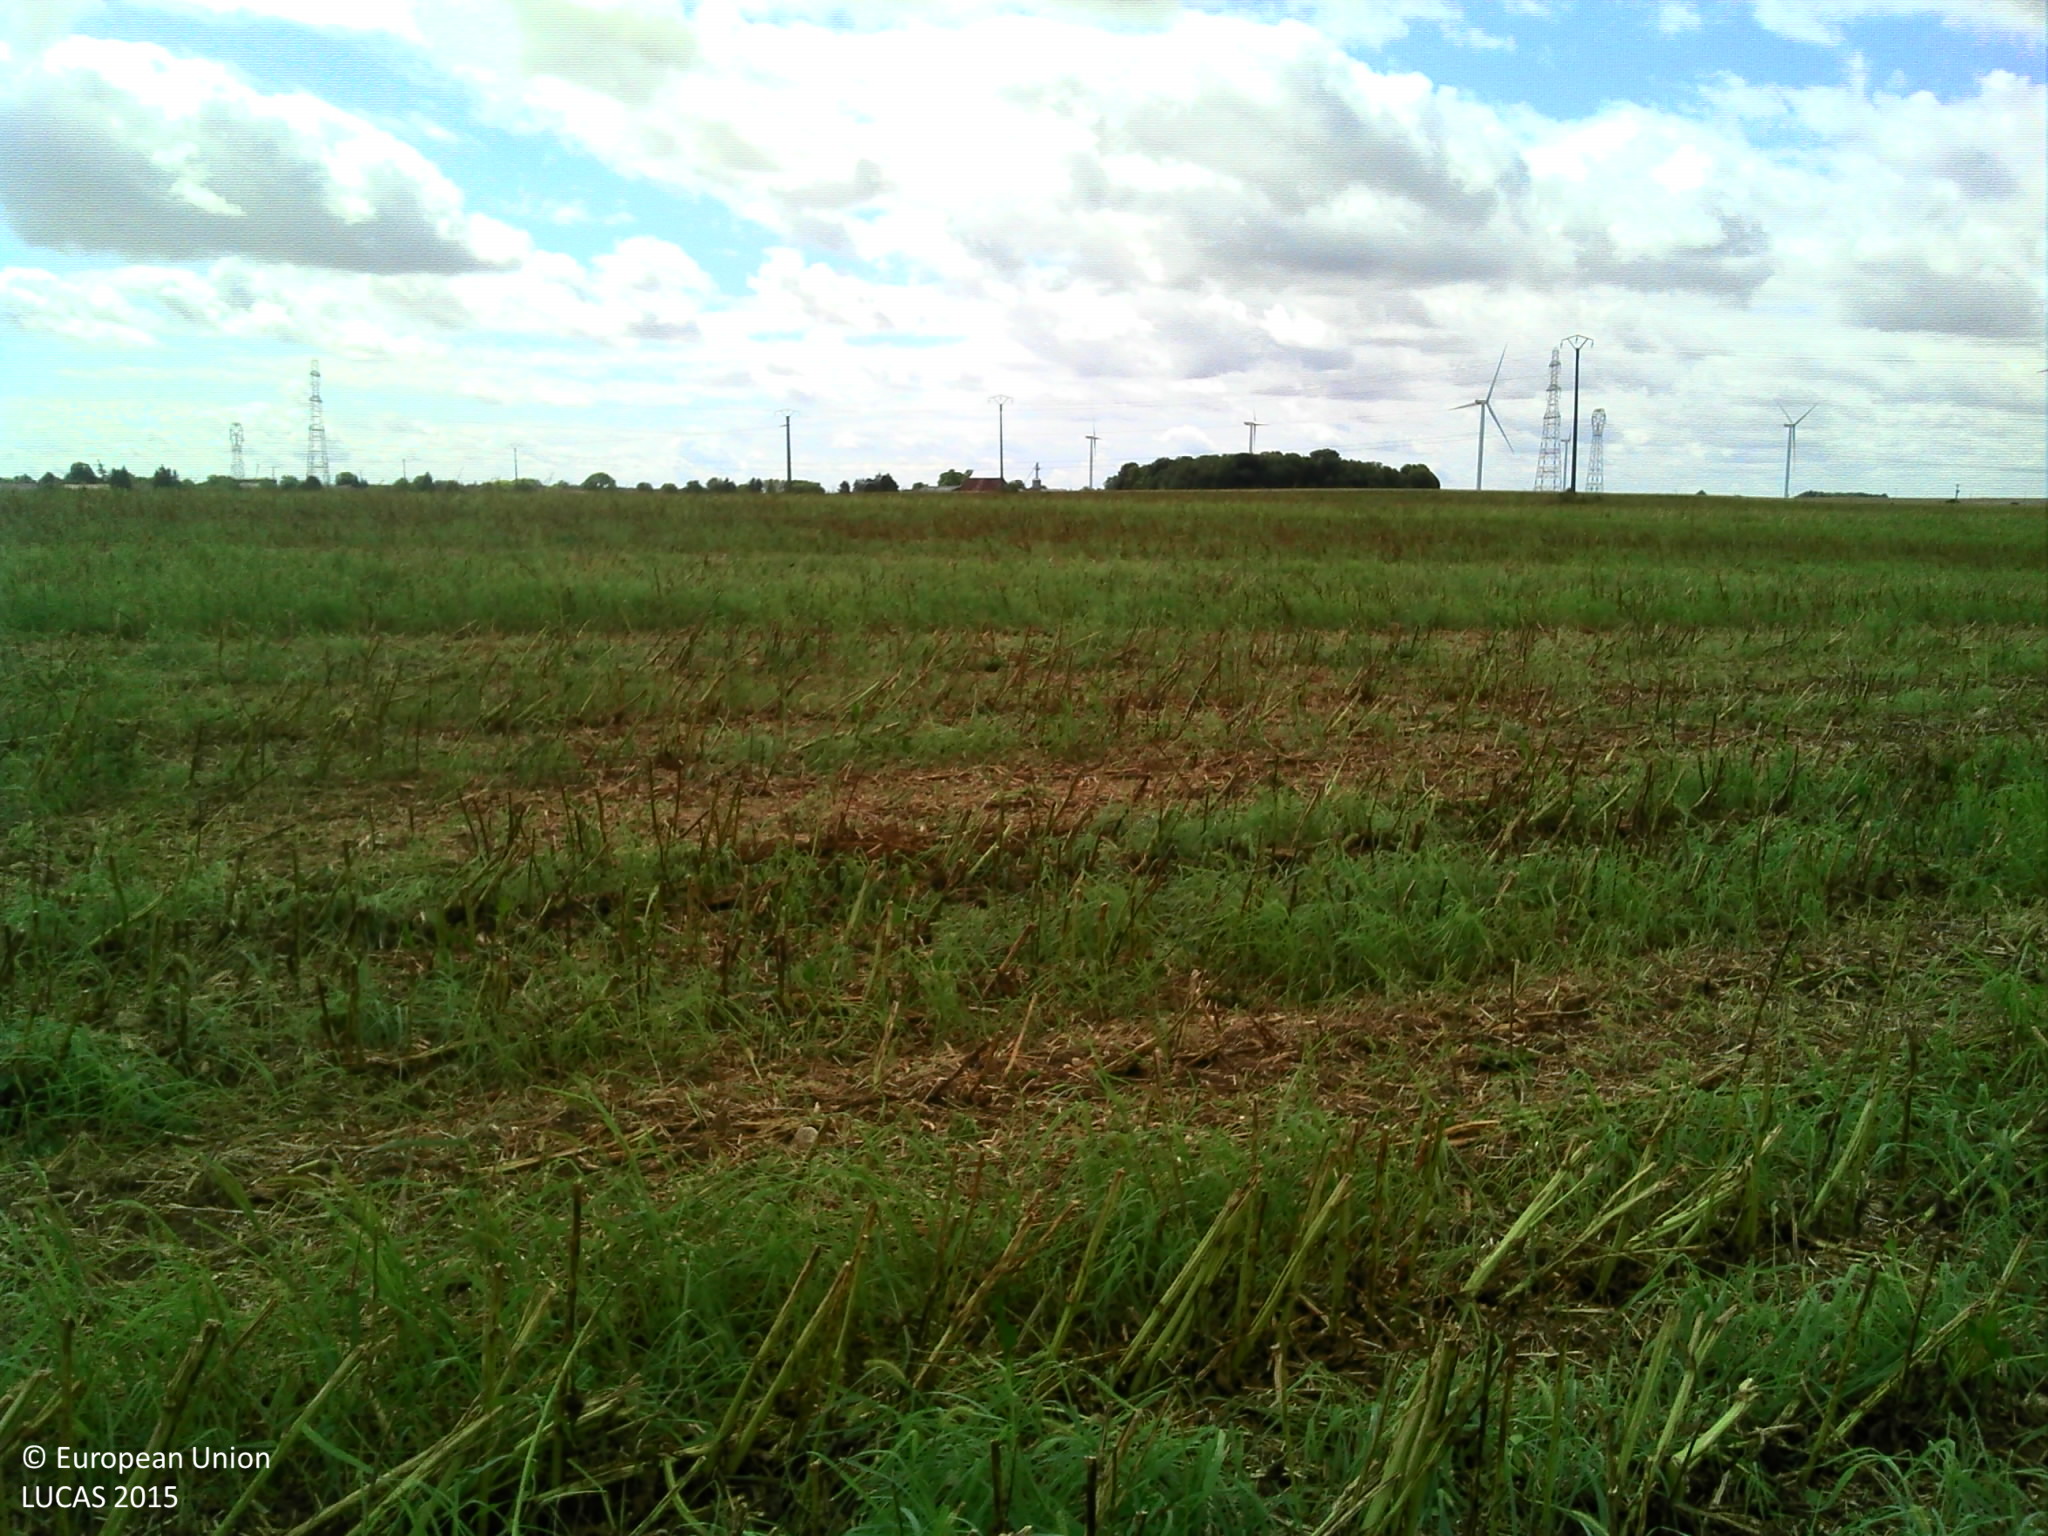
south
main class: Cropland
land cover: Rape and turnip rape
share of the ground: 25 - 50 %
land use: Agriculture (excluding fallow land and kitchen gardens)
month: August
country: FR
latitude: 47.1078
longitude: 2.0977
